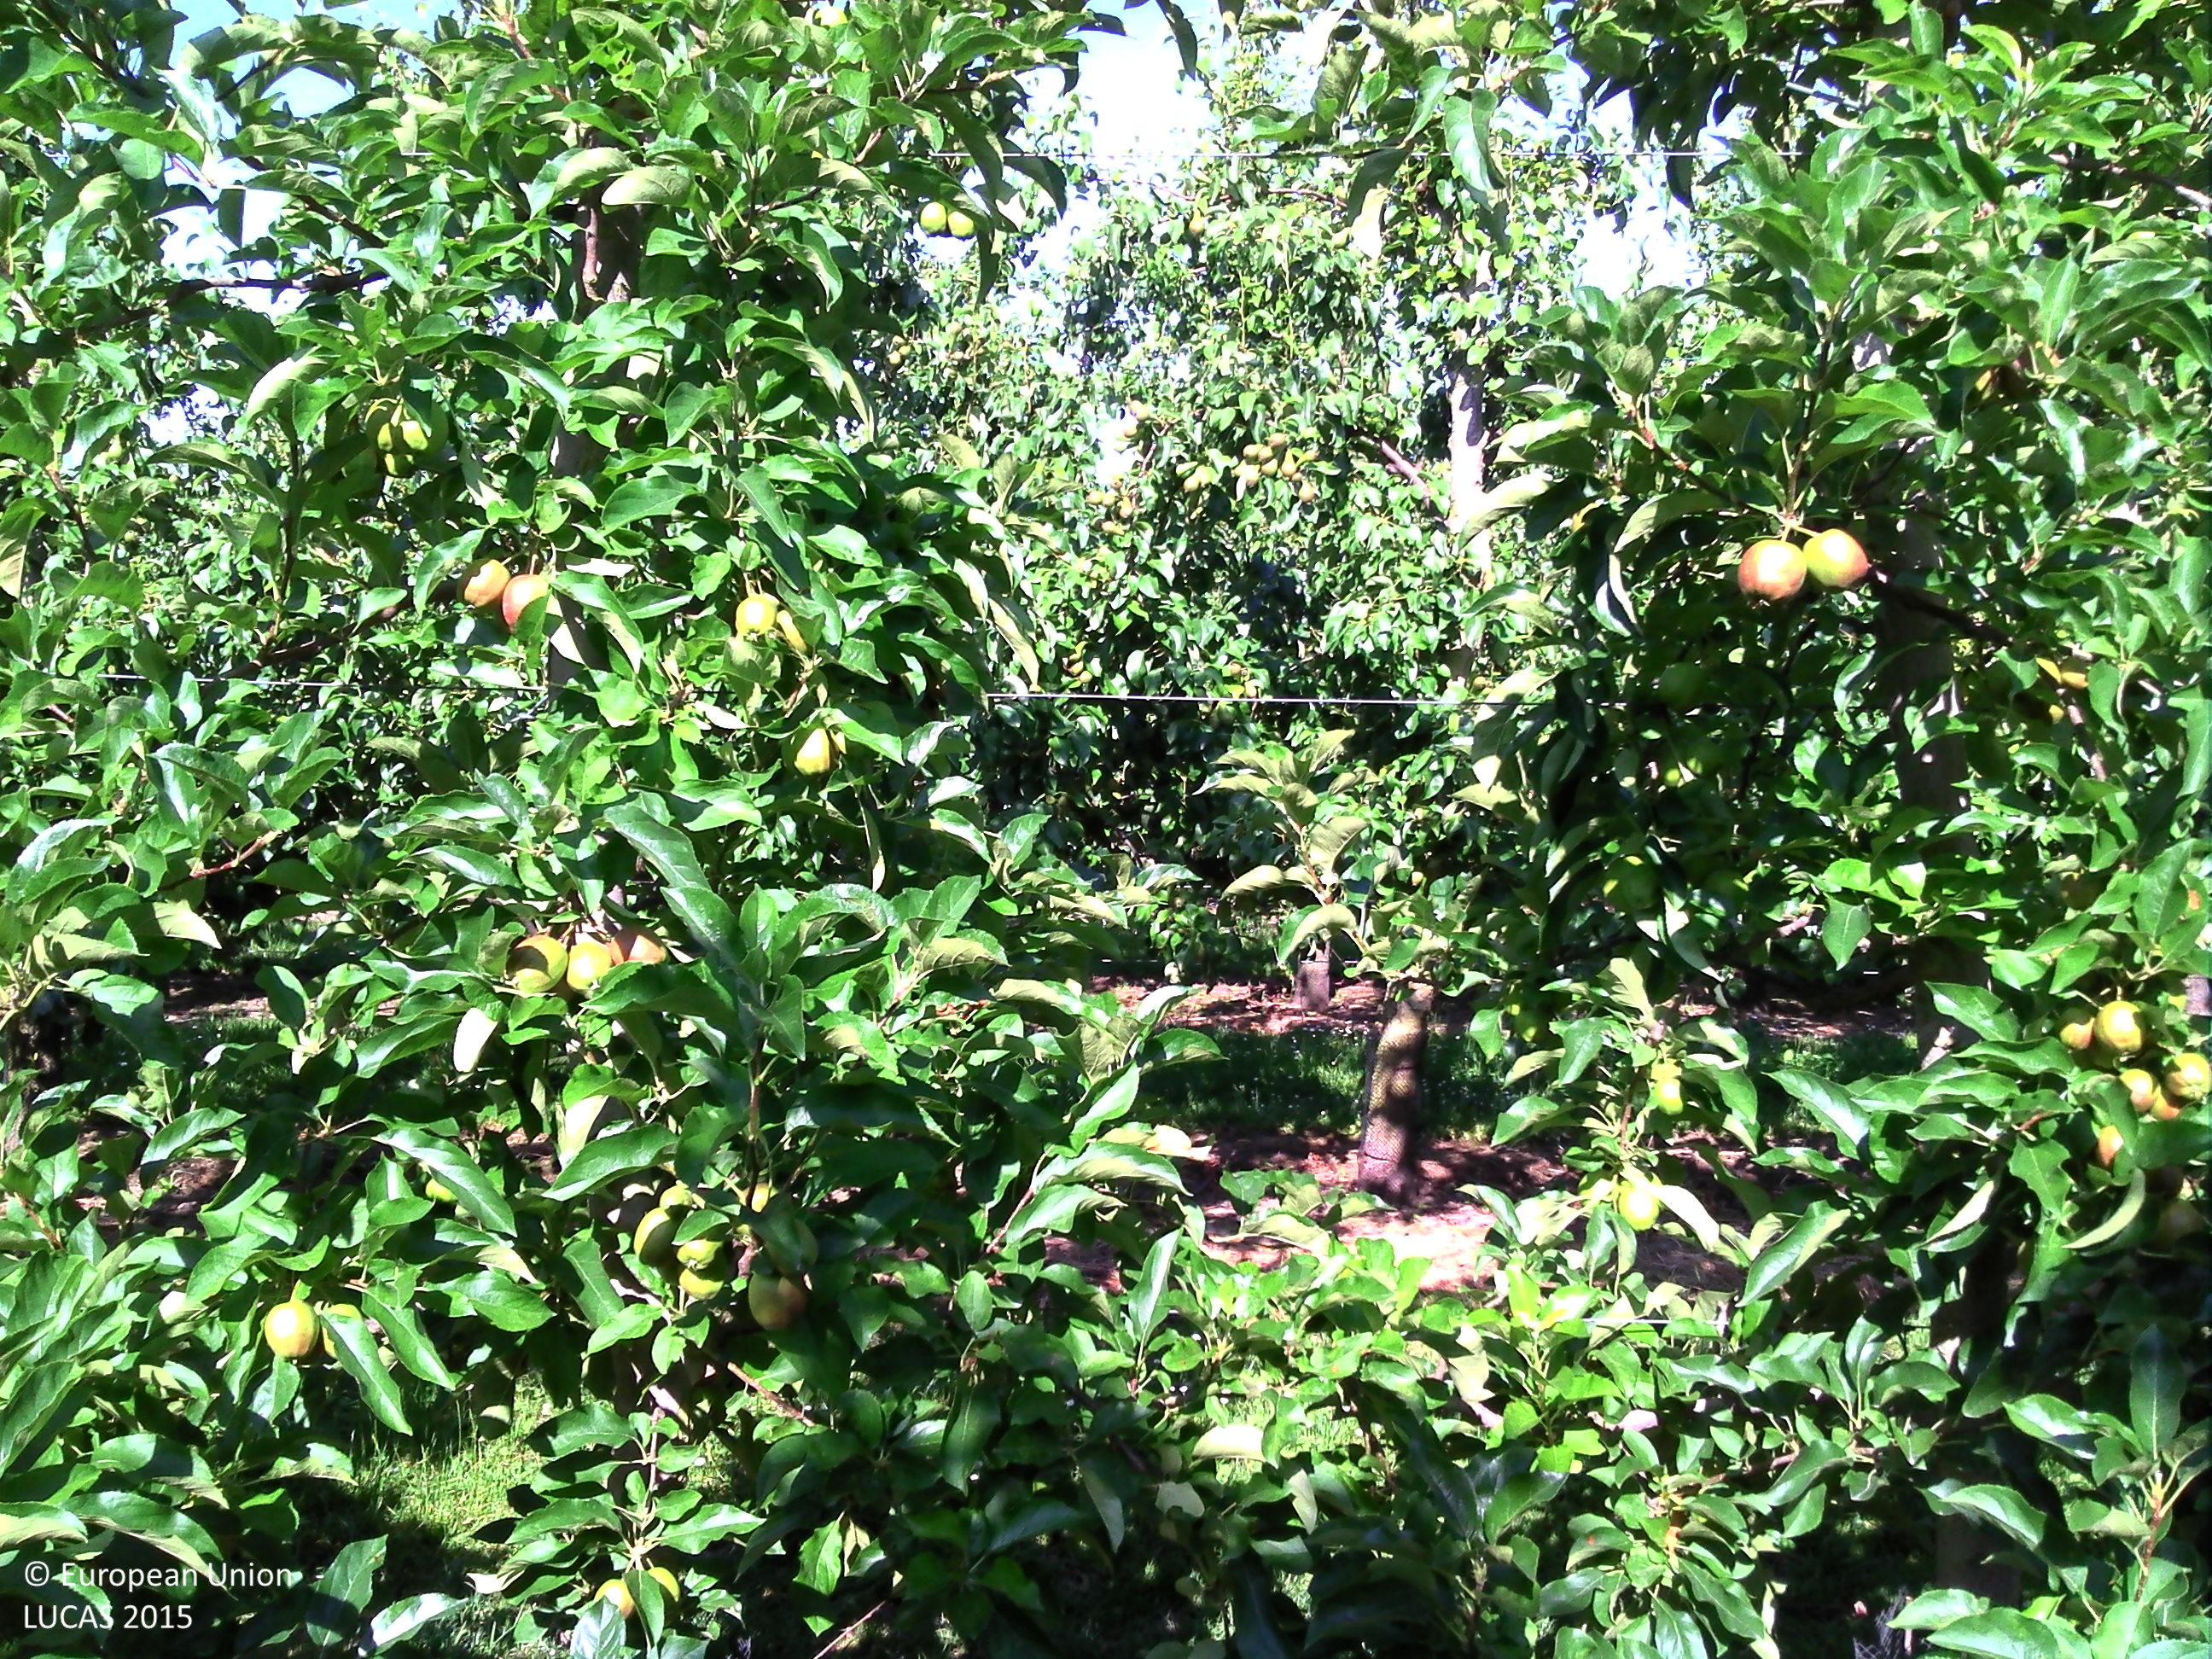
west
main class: Cropland
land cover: Apple fruit
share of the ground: > 75 %
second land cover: Grassland without tree/shrub cover
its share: > 75 %
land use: Agriculture (excluding fallow land and kitchen gardens)
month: June
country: BE
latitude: 50.8032
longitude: 5.1873
